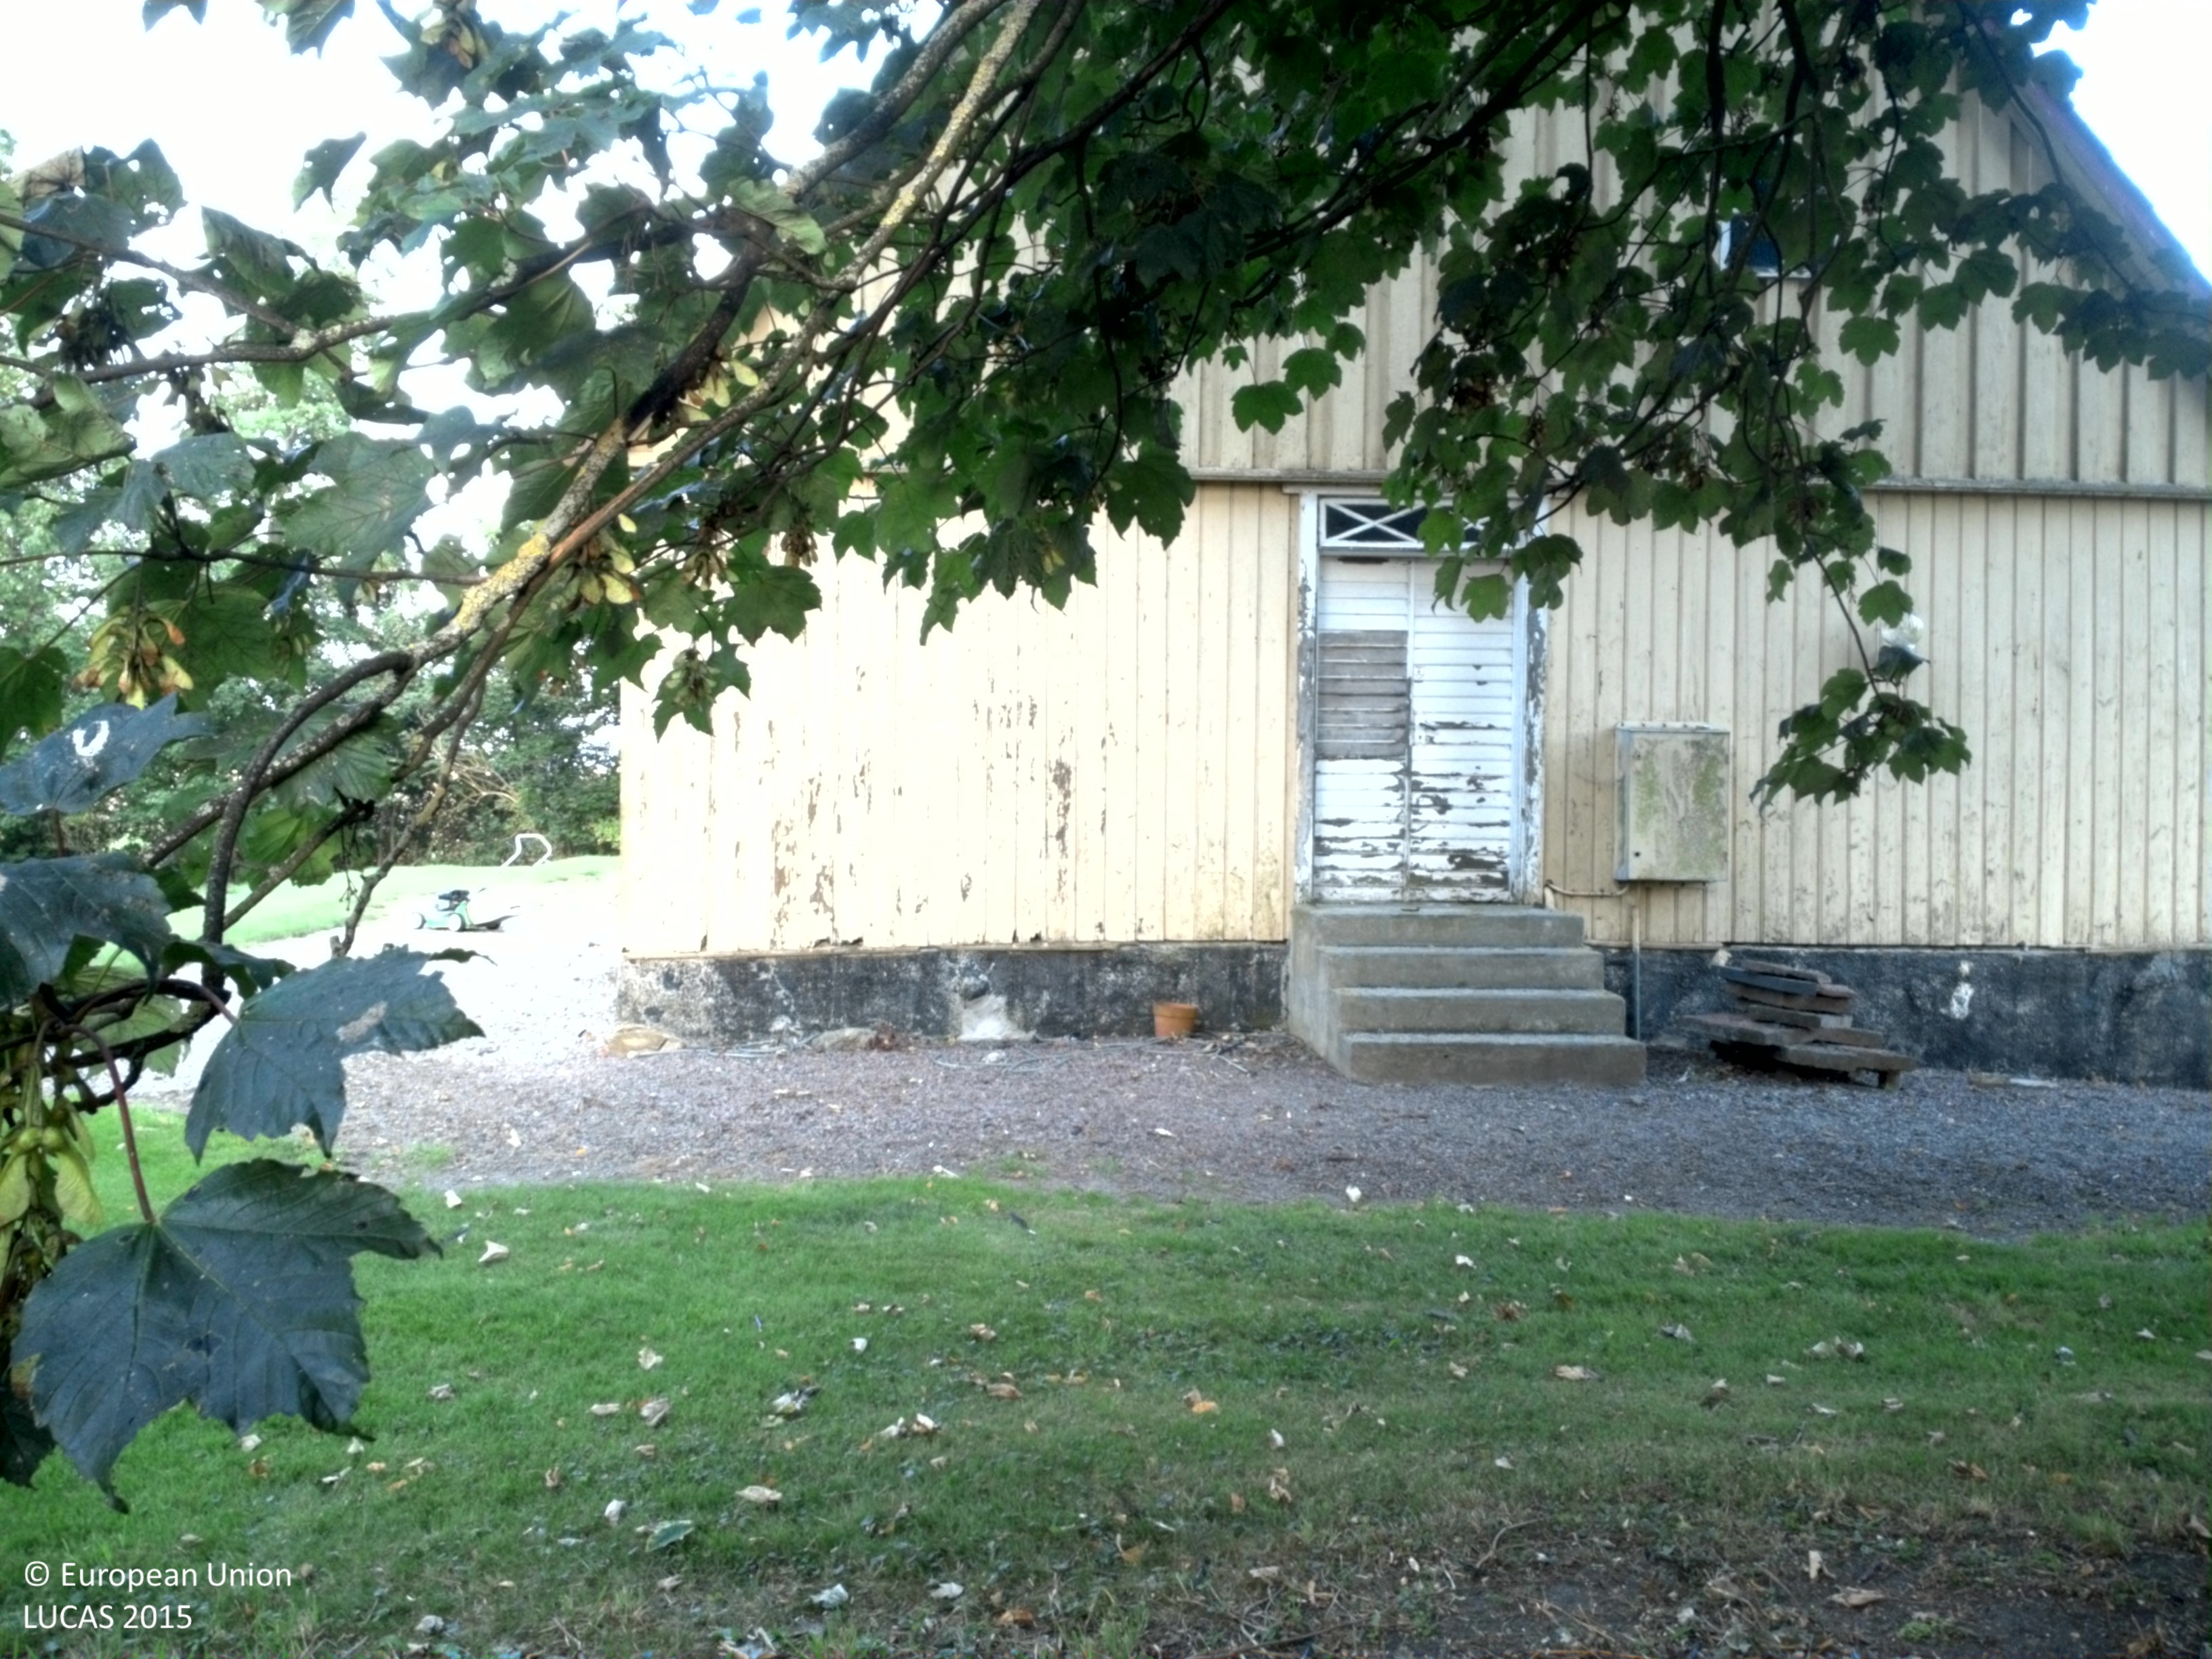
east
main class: Shrubland
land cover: Shrubland with sparse tree cover
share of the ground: 50 - 75 %
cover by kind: shrubs 60 %, herbaceous plants 35 %, broadleaved forest trees 5 %
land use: Residential
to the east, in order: Shrubland with sparse tree cover; Spontaneously vegetated surfaces; Artificial constructions in urban areas; Spontaneously vegetated surfaces; Other bare soil; Electric lines; Other bare soil
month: August
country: SE
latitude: 55.4350
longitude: 13.6176
